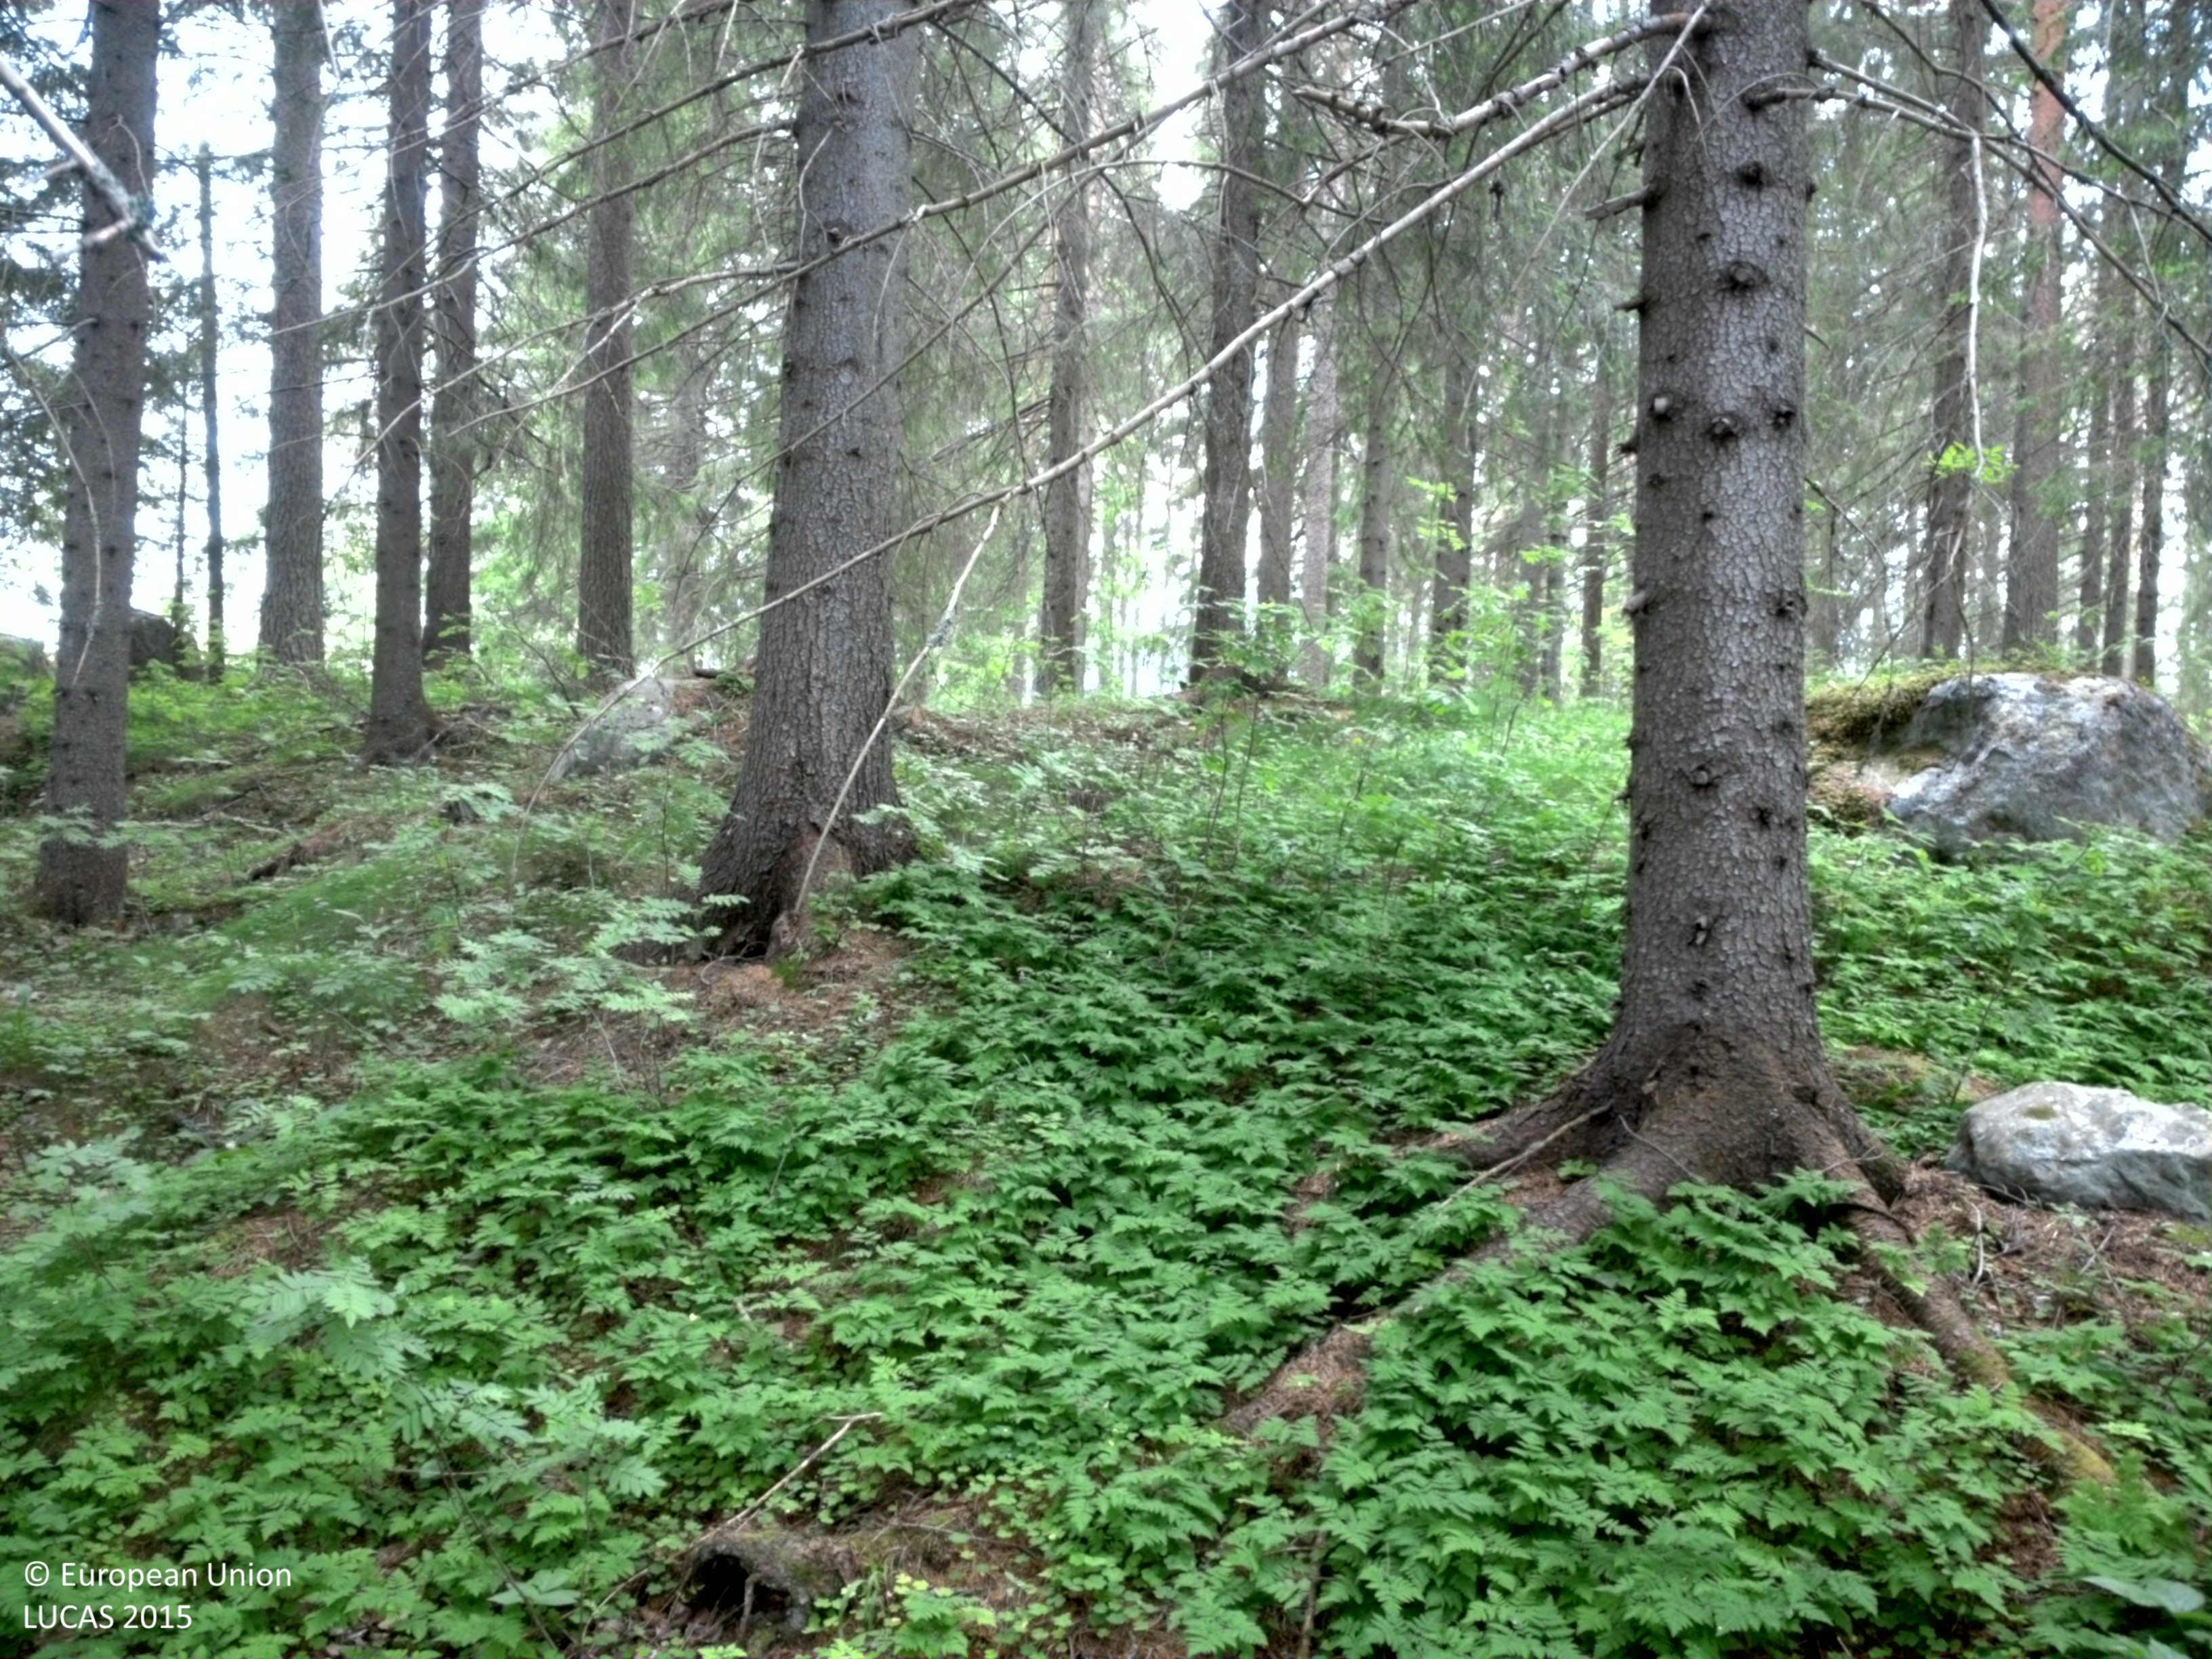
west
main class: Woodland
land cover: Spruce dominated coniferous woodland
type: boreal forest
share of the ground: > 75 %
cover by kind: coniferous forest trees 80 %, herbaceous plants 20 %
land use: Forestry
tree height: > 5 m
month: July
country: SE
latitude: 64.5112
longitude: 20.9563
